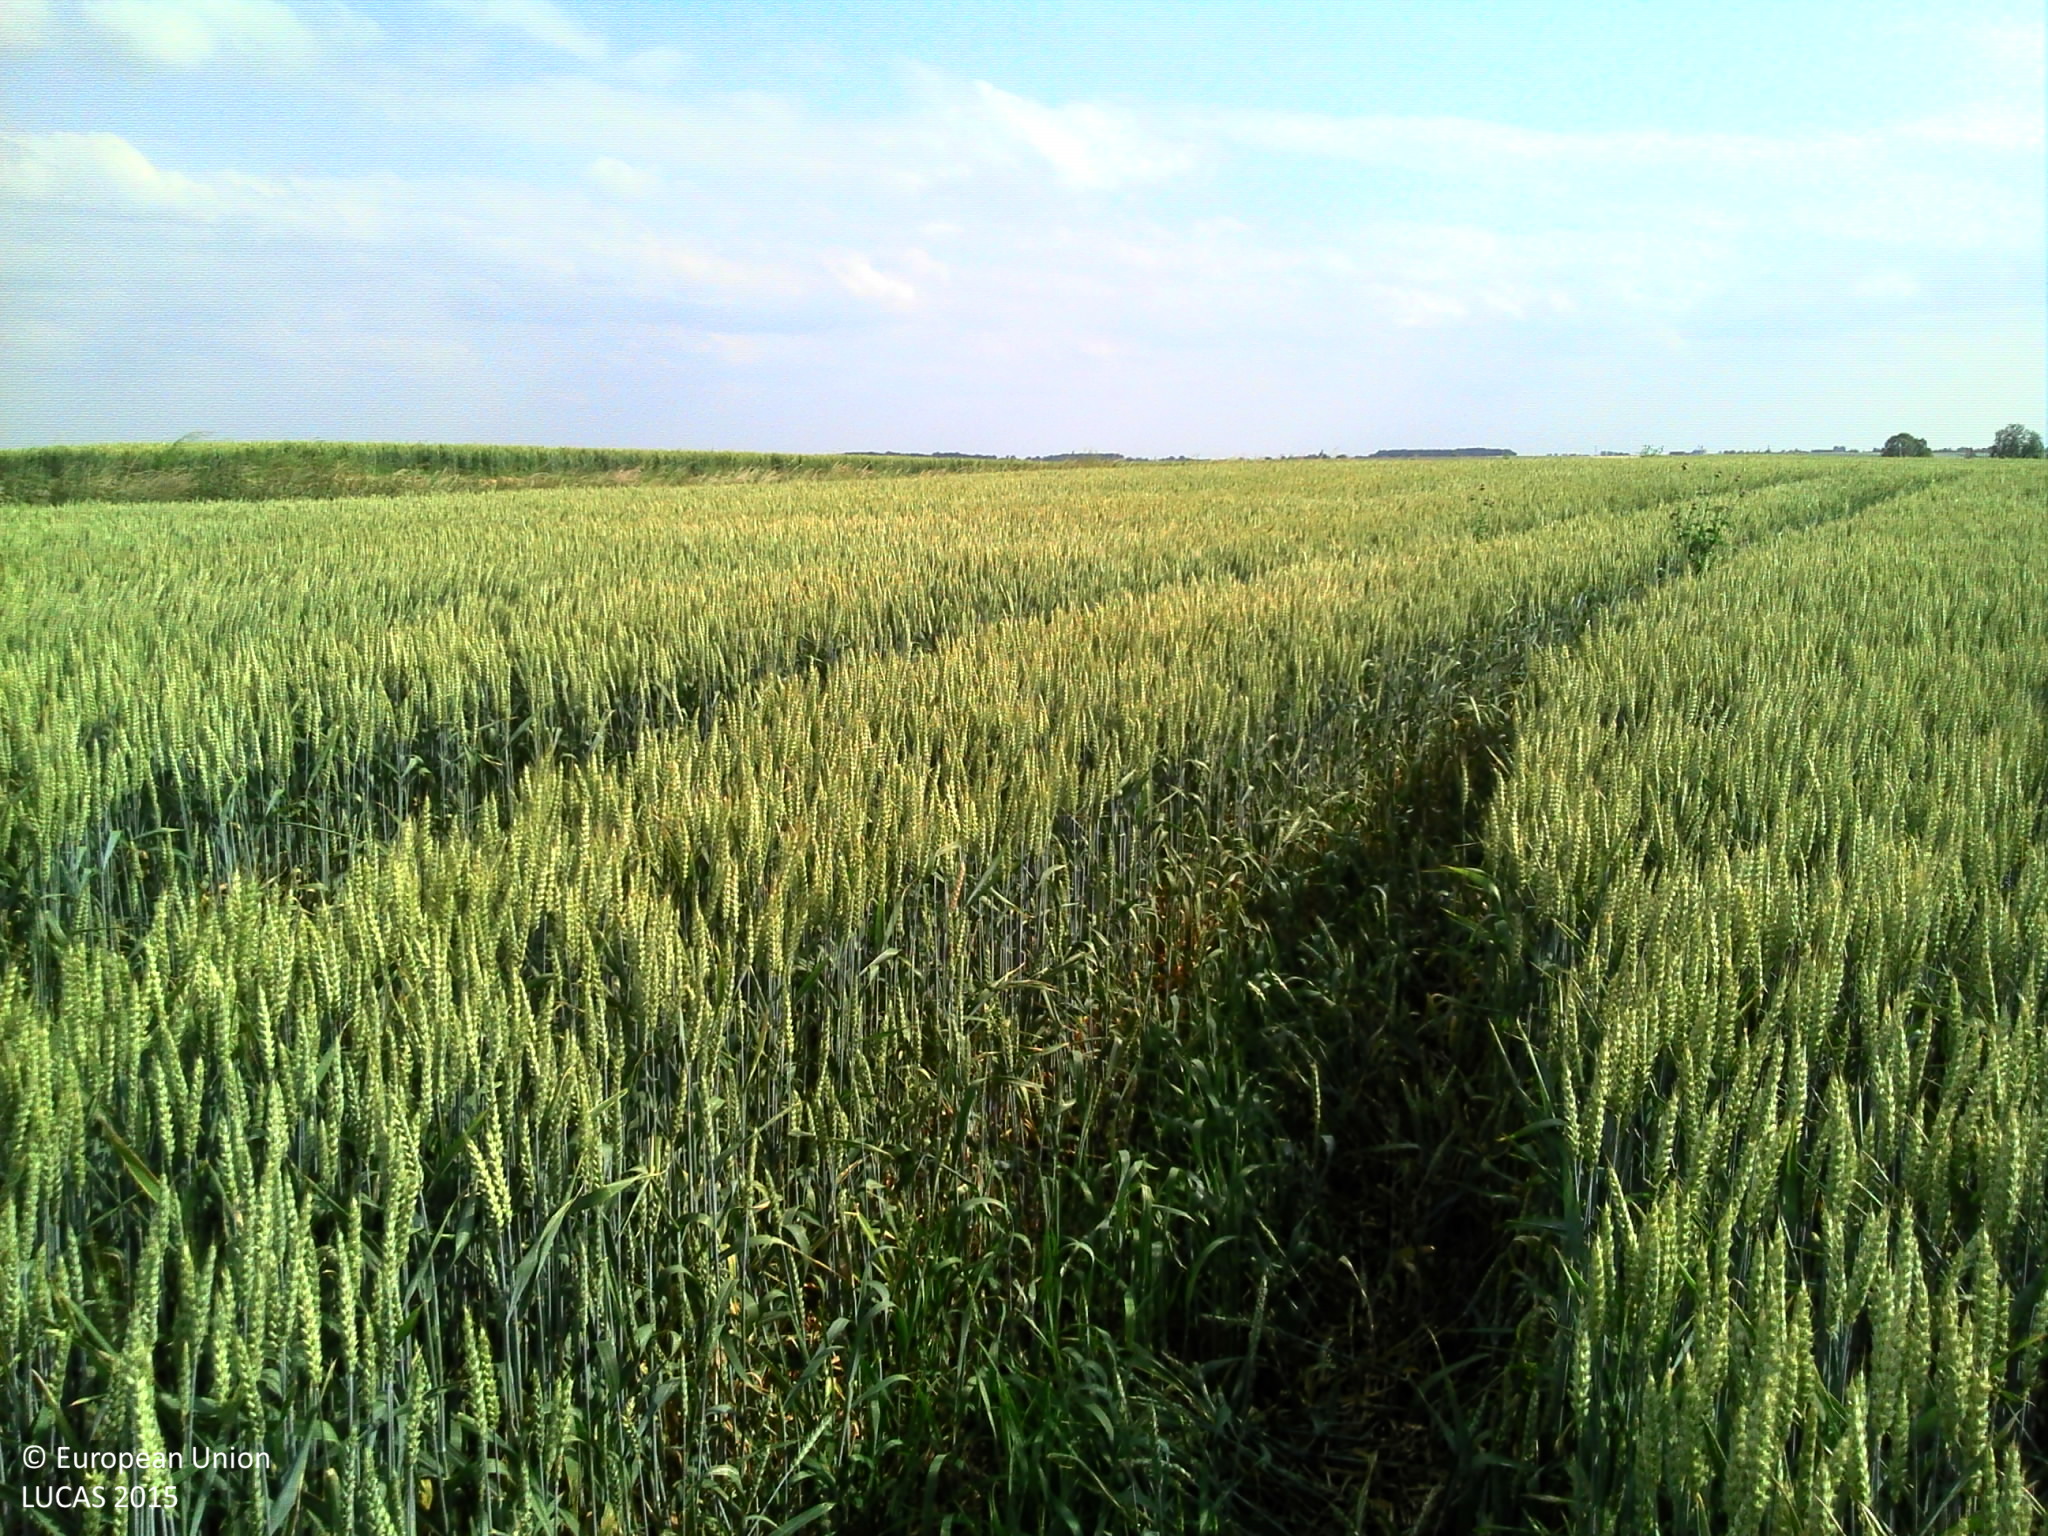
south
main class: Cropland
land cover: Common wheat
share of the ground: > 75 %
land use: Agriculture (excluding fallow land and kitchen gardens)
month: June
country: FR
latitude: 46.8441
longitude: 0.2094
